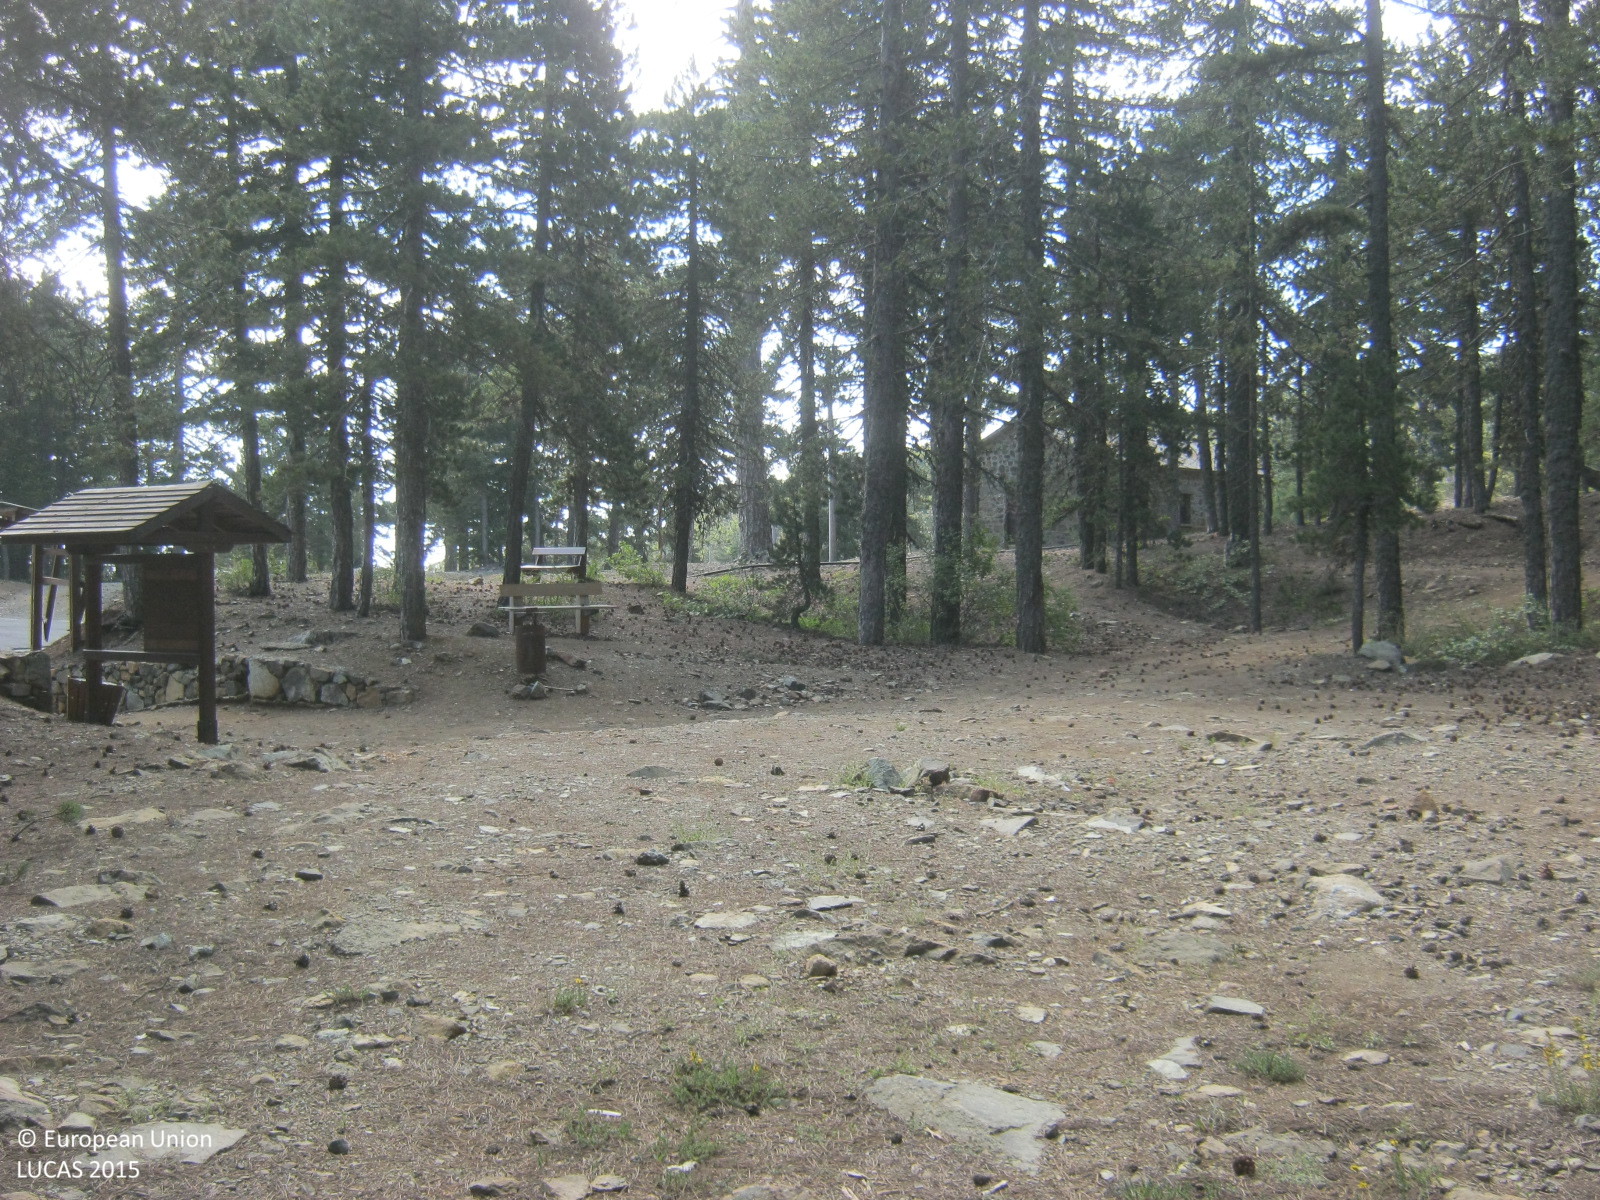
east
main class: Woodland
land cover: Pine dominated coniferous woodland
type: coniferous forest of the mediterranean region
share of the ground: > 75 %
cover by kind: coniferous forest trees 80 %, unconsolidated bare surface 15 %, shrubs 5 %
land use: Forestry
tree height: > 5 m
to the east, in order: Pine dominated coniferous woodland; Paved roads, cycling and walking lanes; Pine dominated coniferous woodland; Electric lines; Pine dominated coniferous woodland; Tracks; Pine dominated coniferous woodland
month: June
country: CY
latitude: 34.9412
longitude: 32.8638
